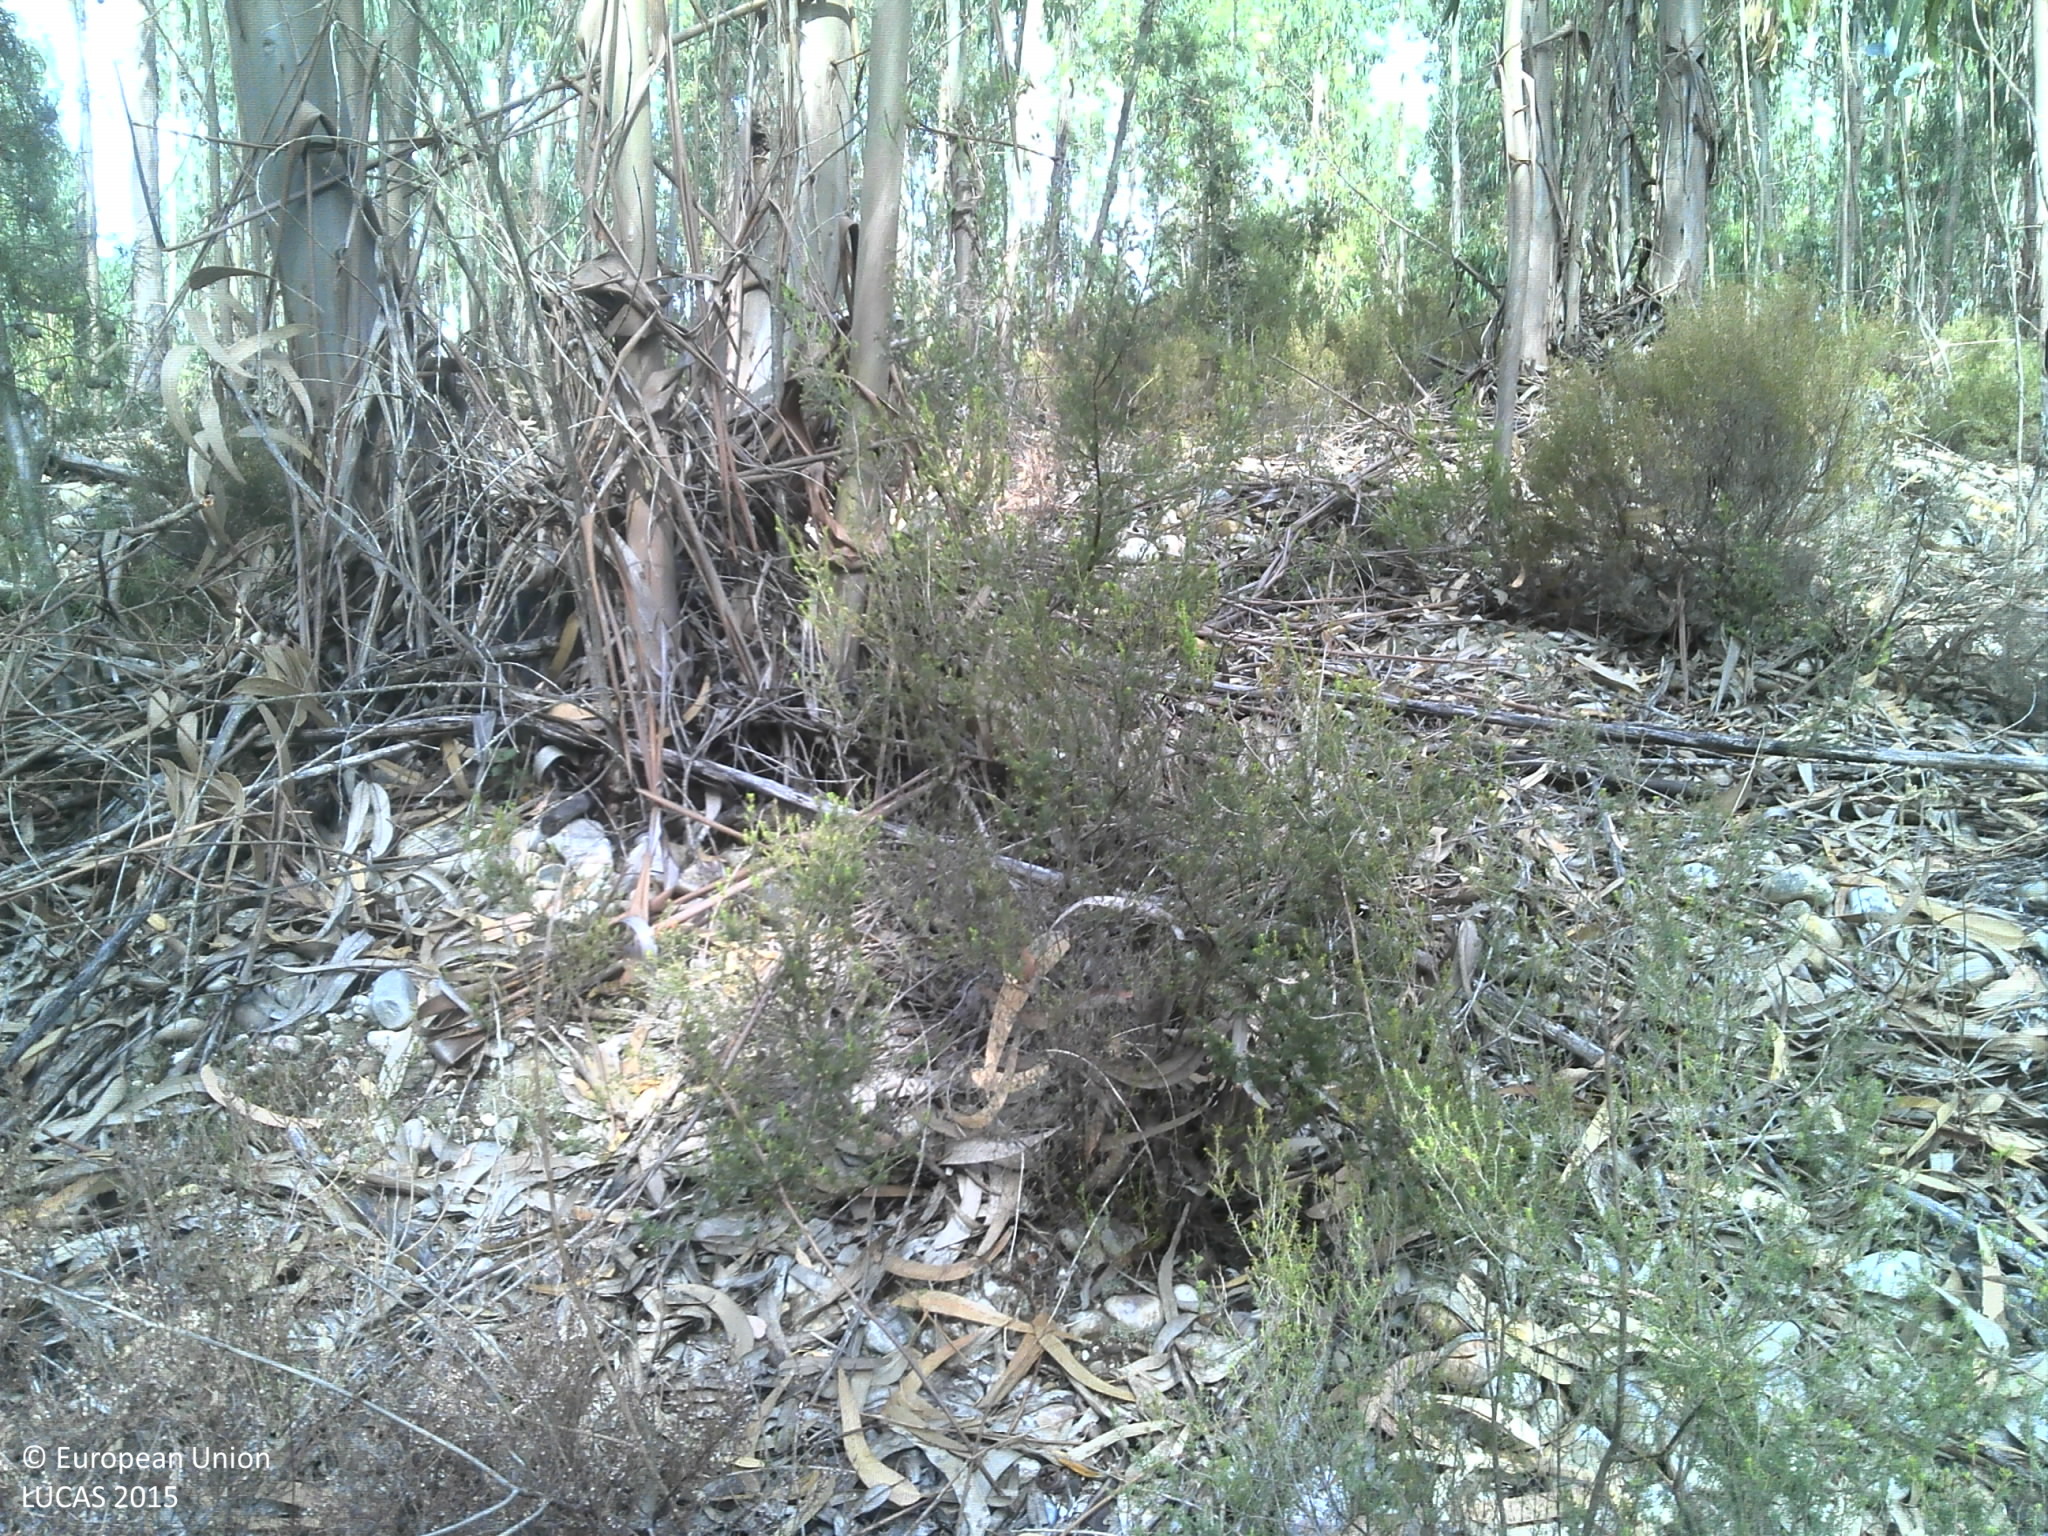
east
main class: Woodland
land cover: Broadleaved woodland
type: exotic forest
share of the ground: 50 - 75 %
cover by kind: broadleaved forest trees 70 %, shrubs 15 %, unconsolidated bare surface 15 %
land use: Forestry
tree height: > 5 m
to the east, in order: Broadleaved woodland; Tracks; Broadleaved woodland
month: June
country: PT
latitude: 39.3709
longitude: -8.2524
